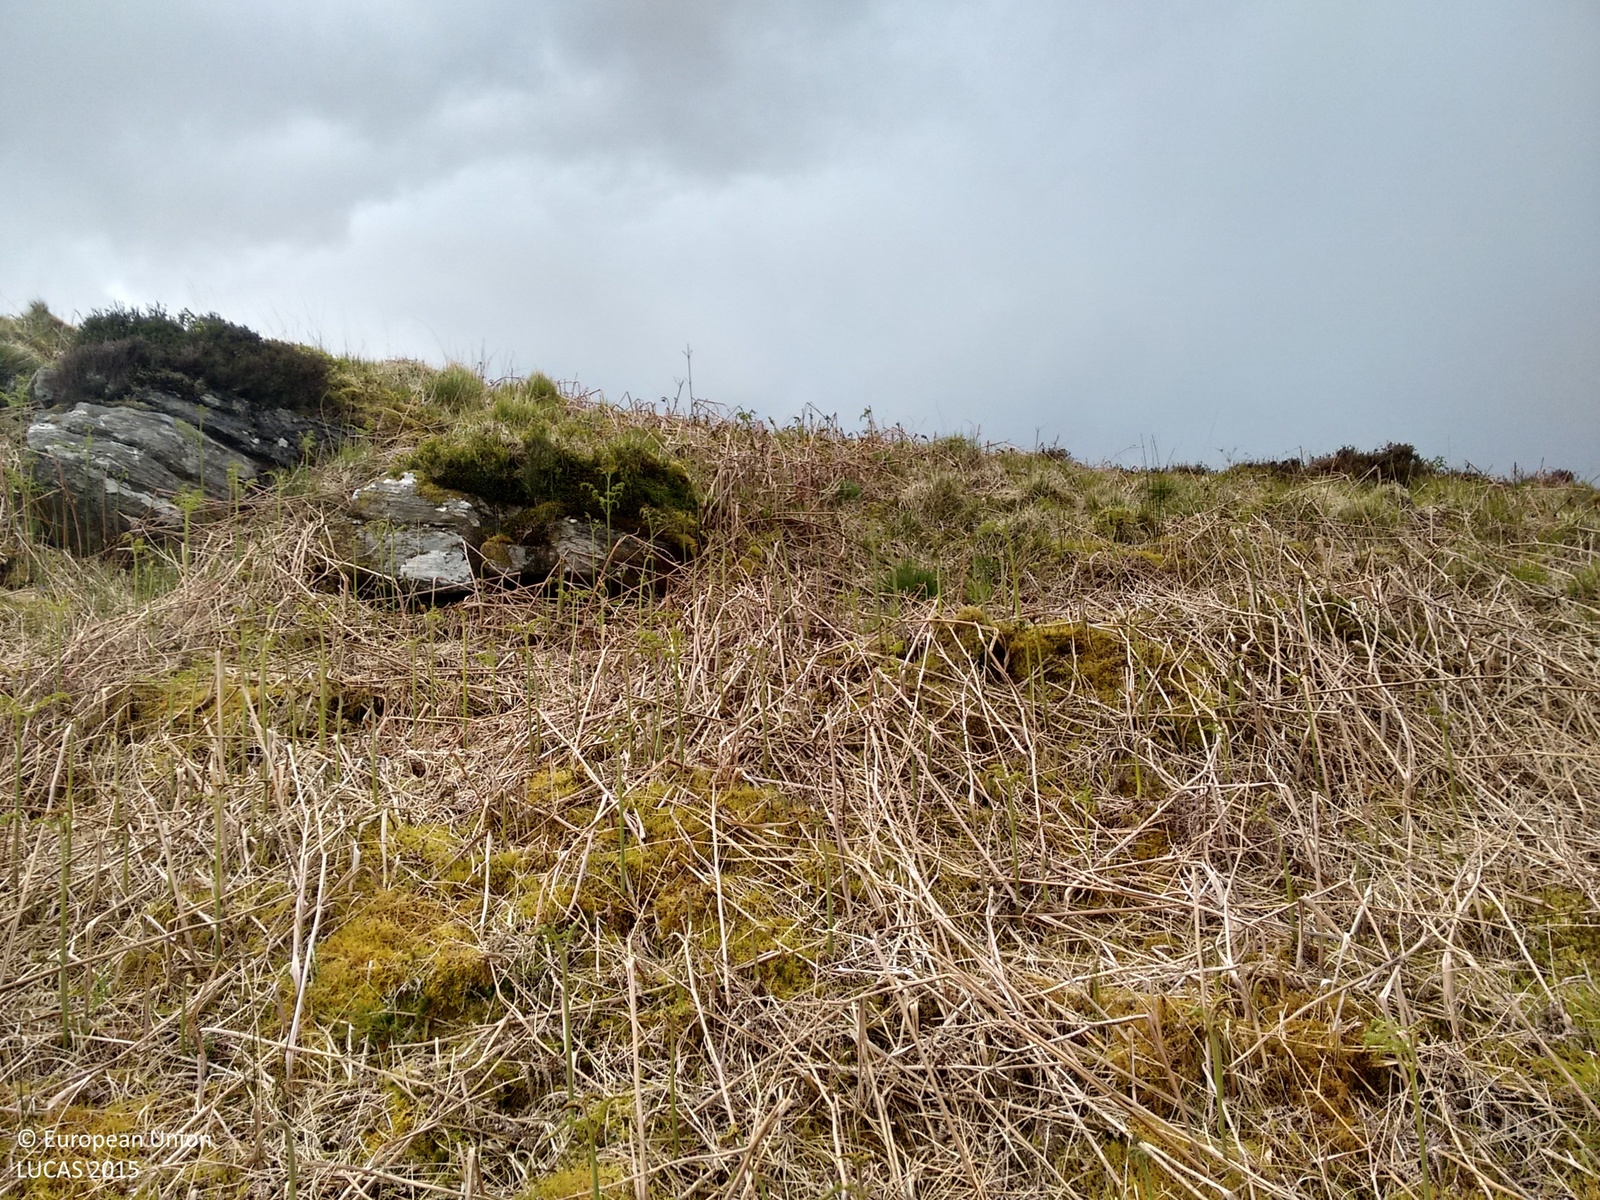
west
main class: Grassland
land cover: Grassland without tree/shrub cover
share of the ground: > 75 %
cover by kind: herbaceous plants 100 %
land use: Semi-natural and natural areas not in use
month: May
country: GB
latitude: 55.9972
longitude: -5.1367
